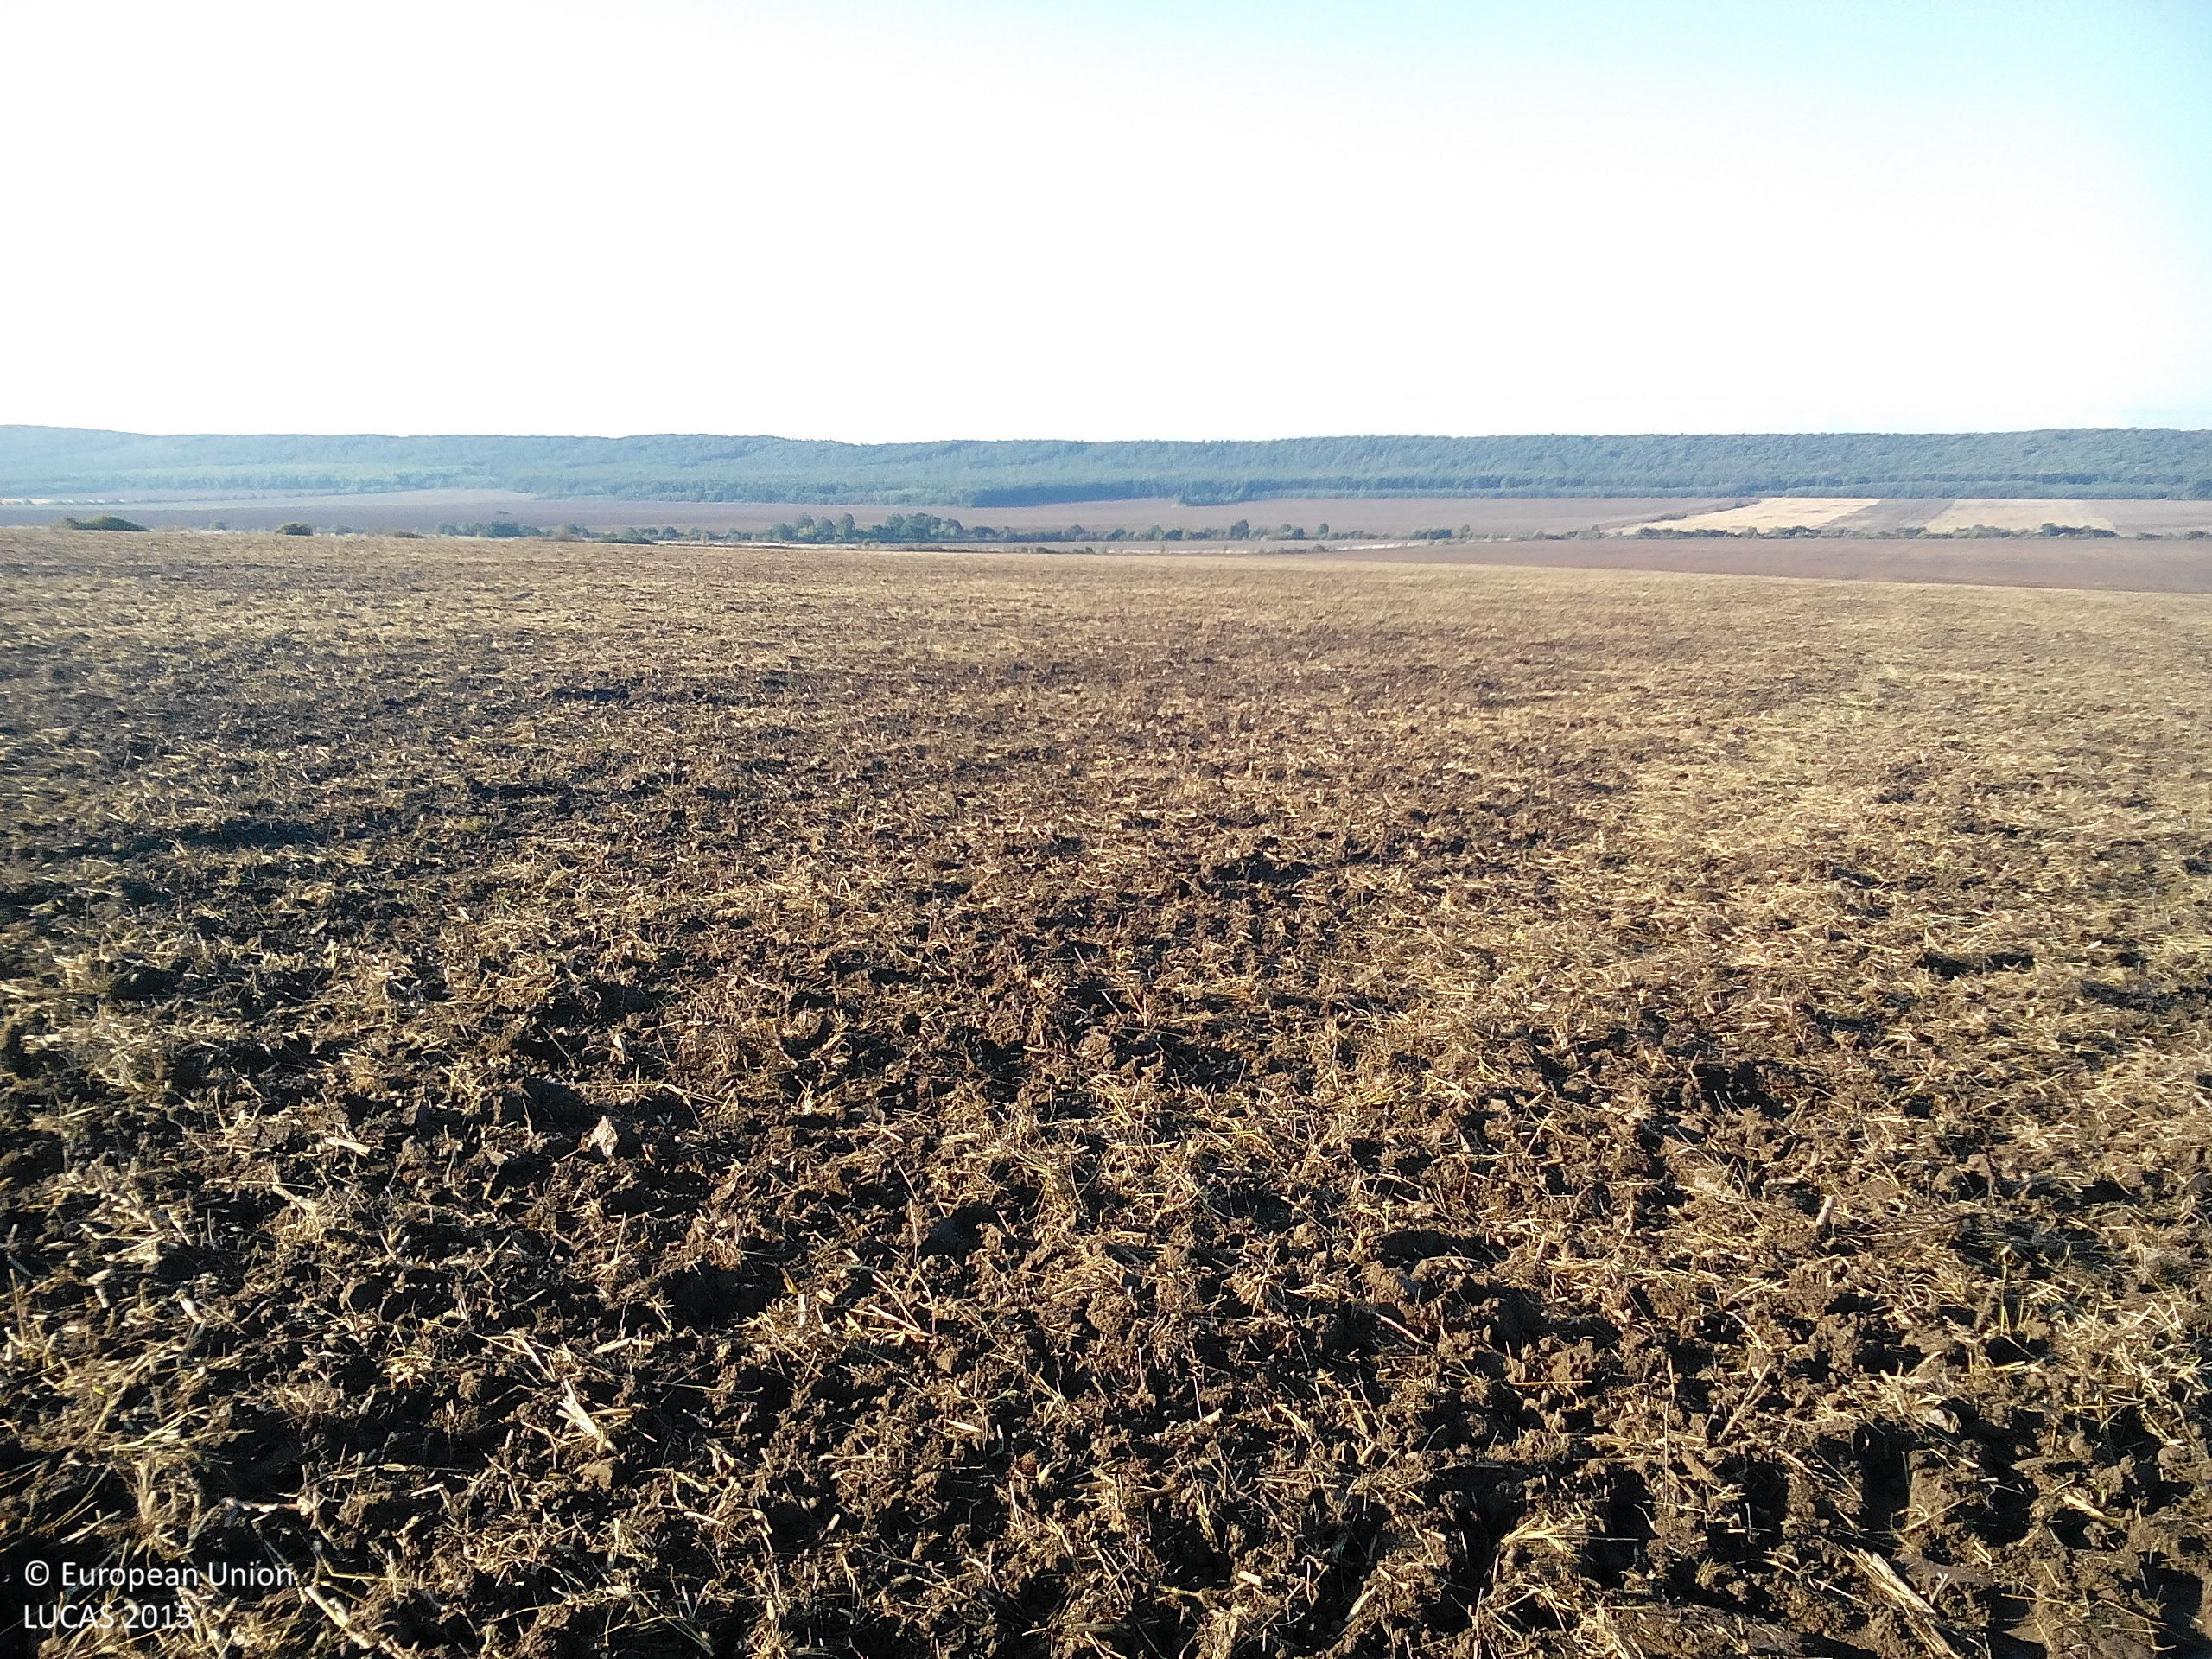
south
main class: Cropland
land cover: Maize
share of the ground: < 10 %
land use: Agriculture (excluding fallow land and kitchen gardens)
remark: Harvested field
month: October
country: BG
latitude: 43.3465
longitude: 23.8280
